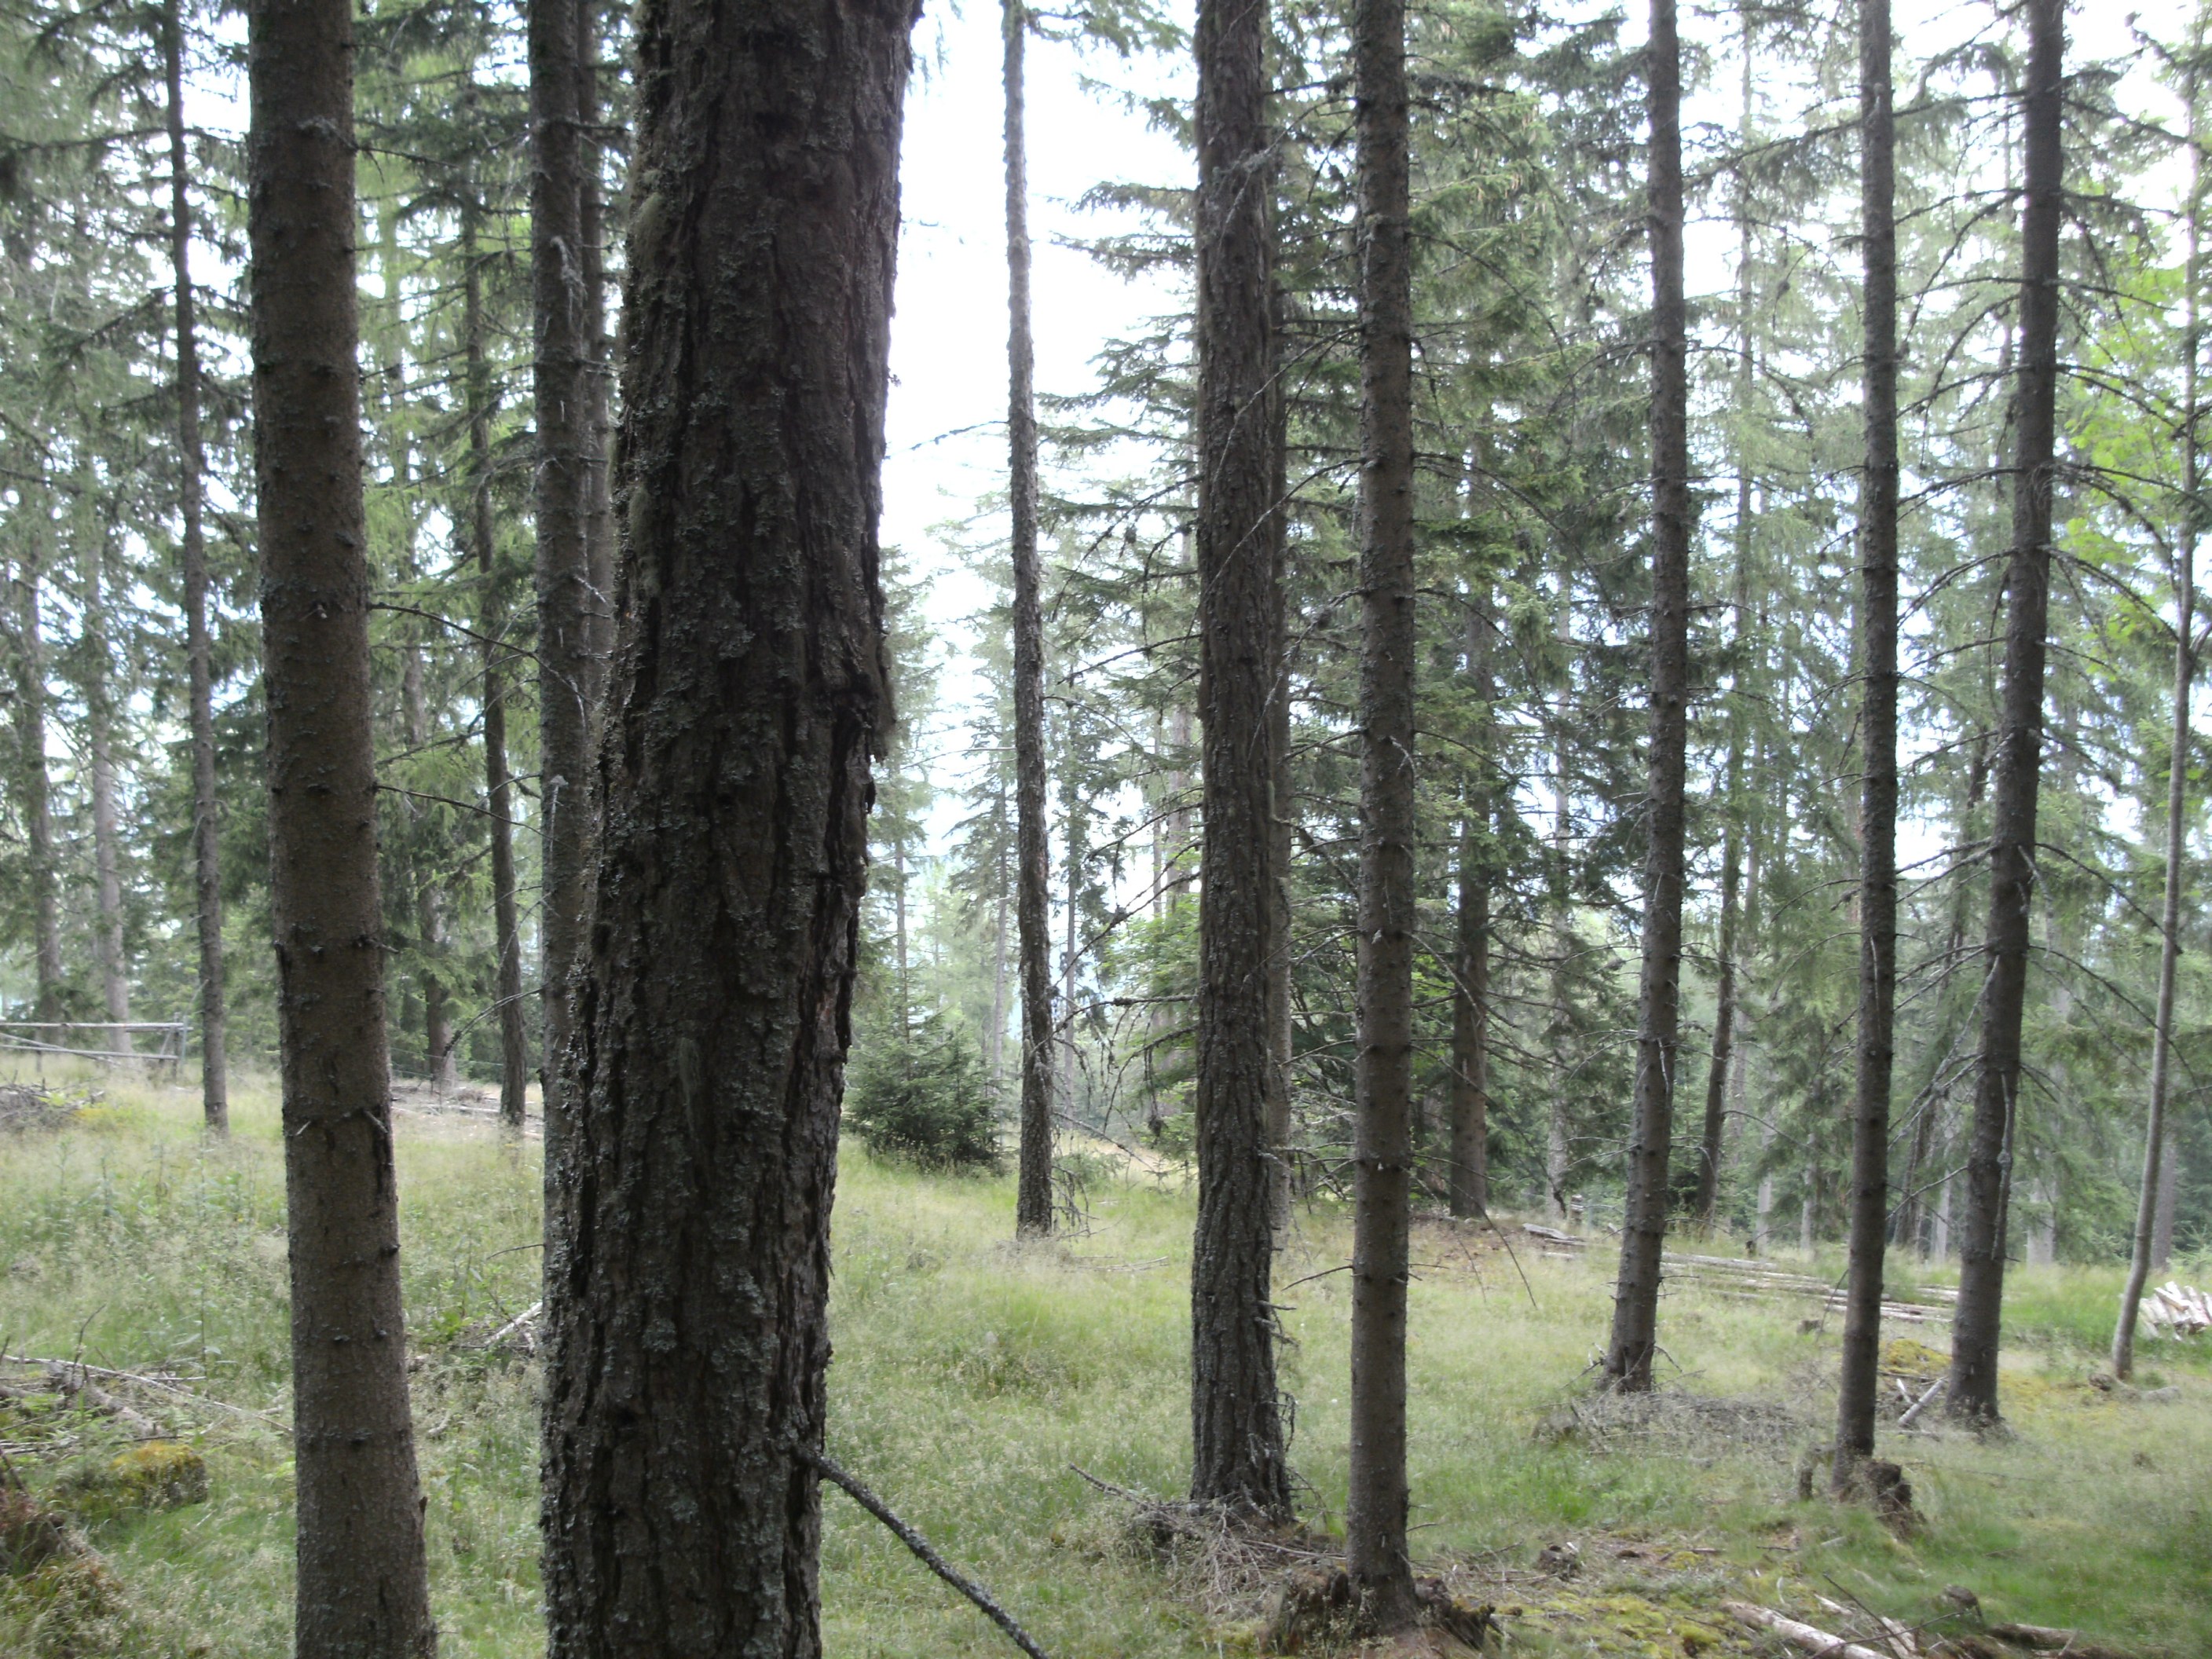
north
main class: Woodland
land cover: Other coniferous woodland
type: alpine coniferous forest
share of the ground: 50 - 75 %
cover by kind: coniferous forest trees 75 %, shrubs 20 %, unconsolidated bare surface 5 %
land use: Forestry
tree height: > 5 m
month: July
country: AT
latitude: 46.9676
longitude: 14.7432
